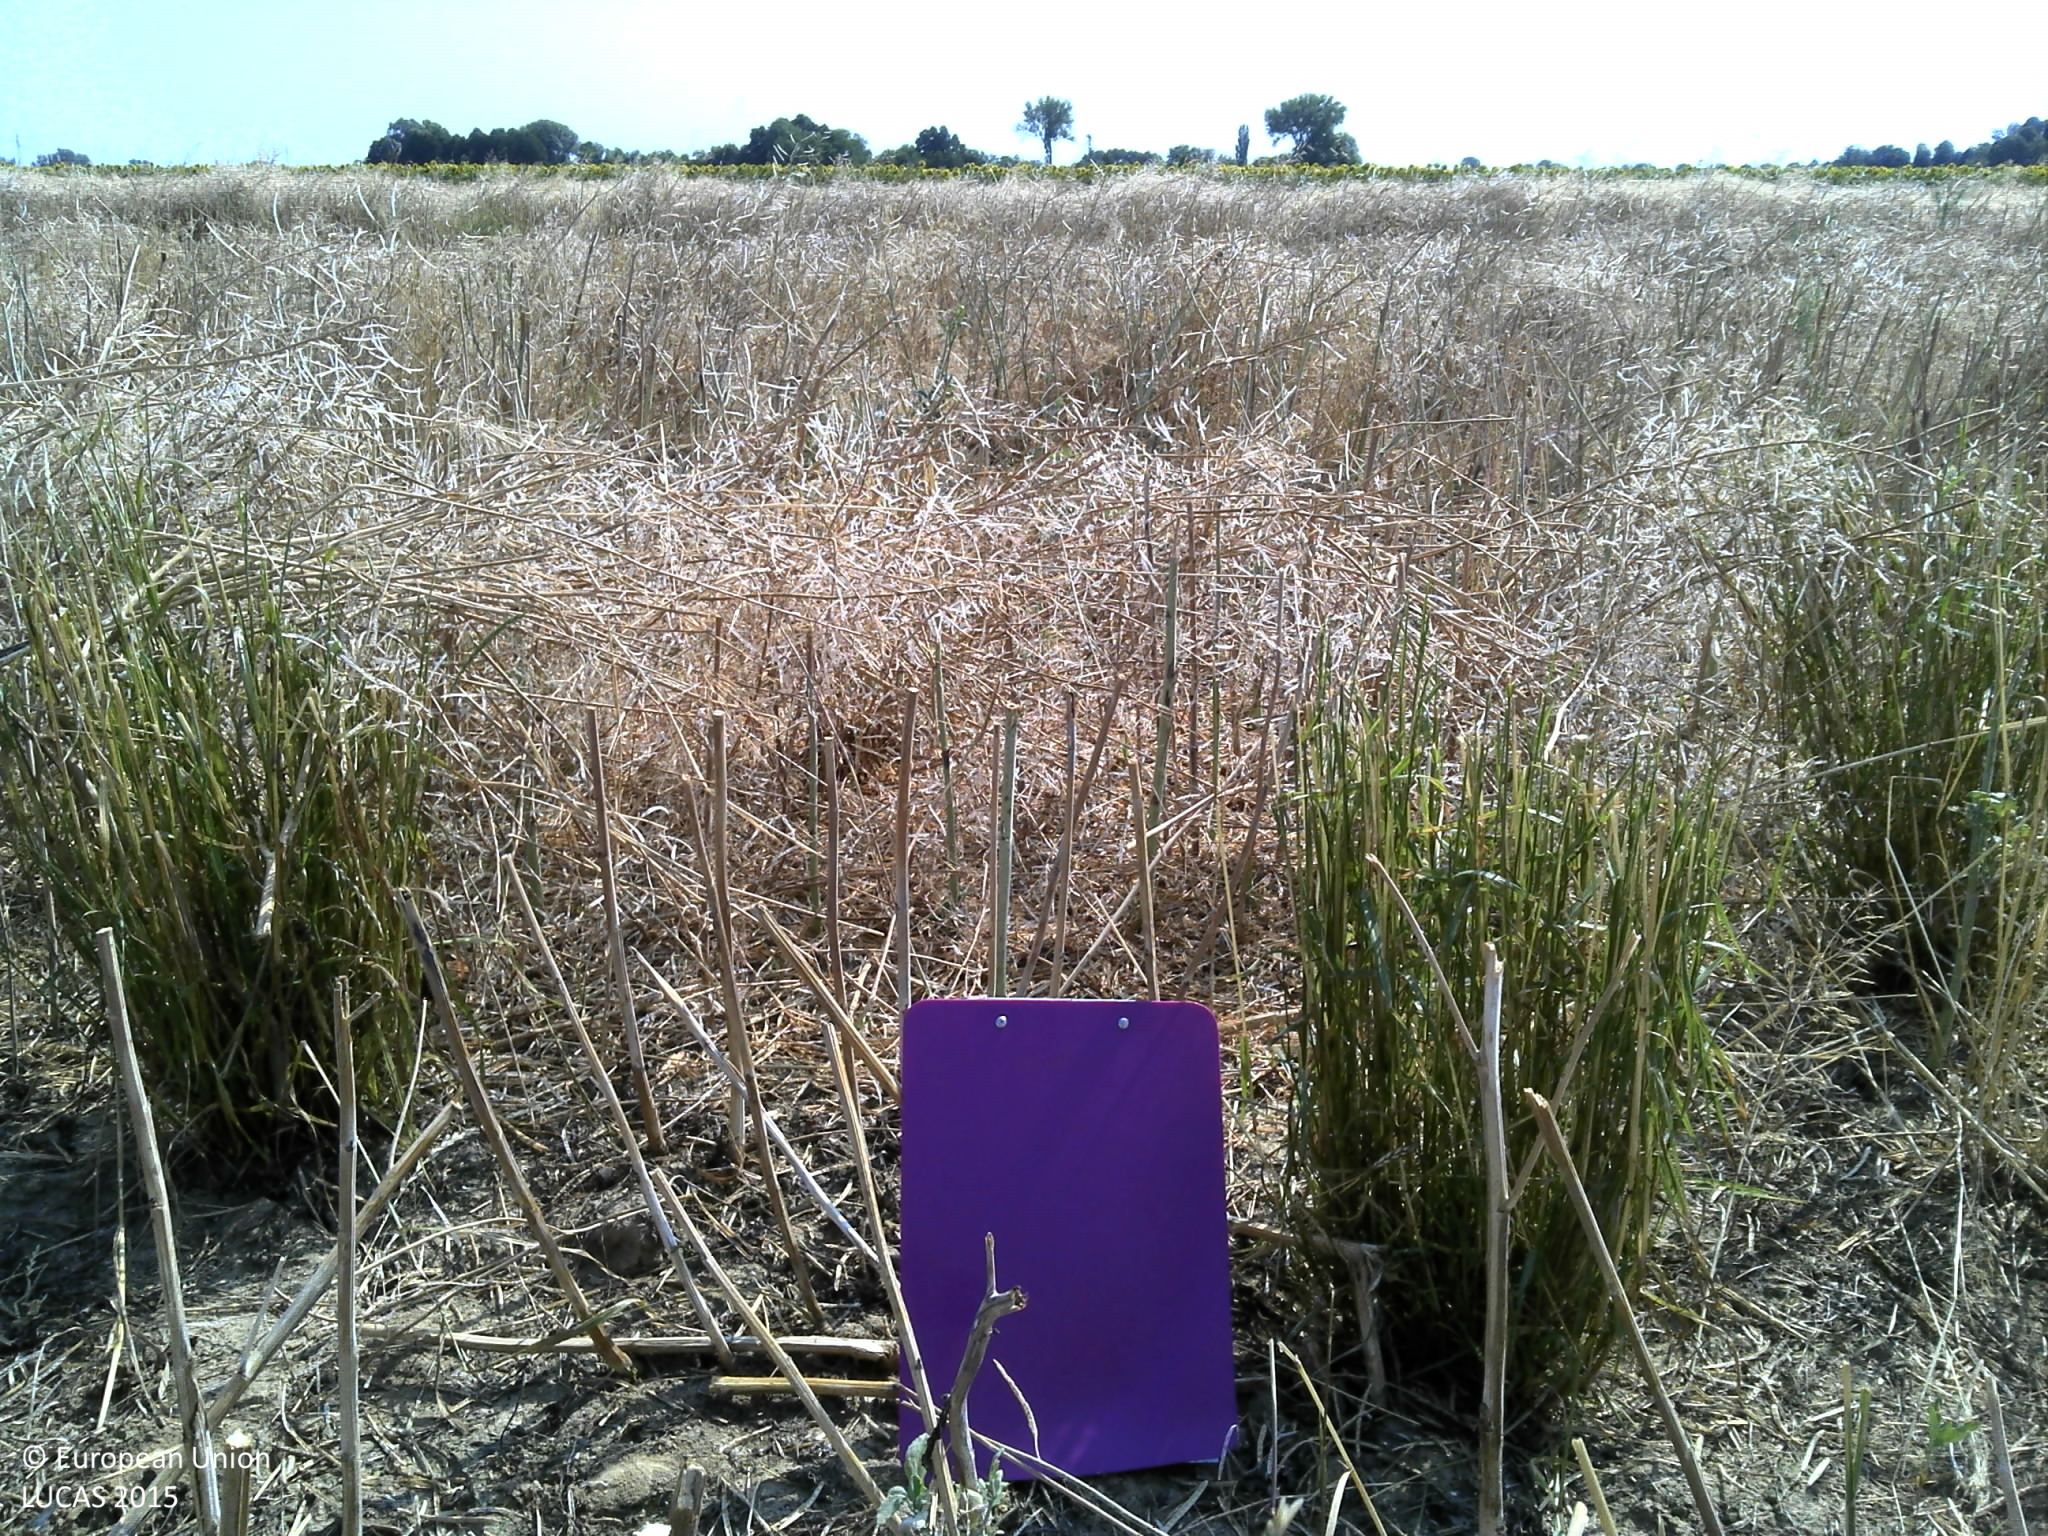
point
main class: Cropland
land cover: Rape and turnip rape
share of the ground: > 75 %
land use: Agriculture (excluding fallow land and kitchen gardens)
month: July
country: HR
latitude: 45.3587
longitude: 18.5206
